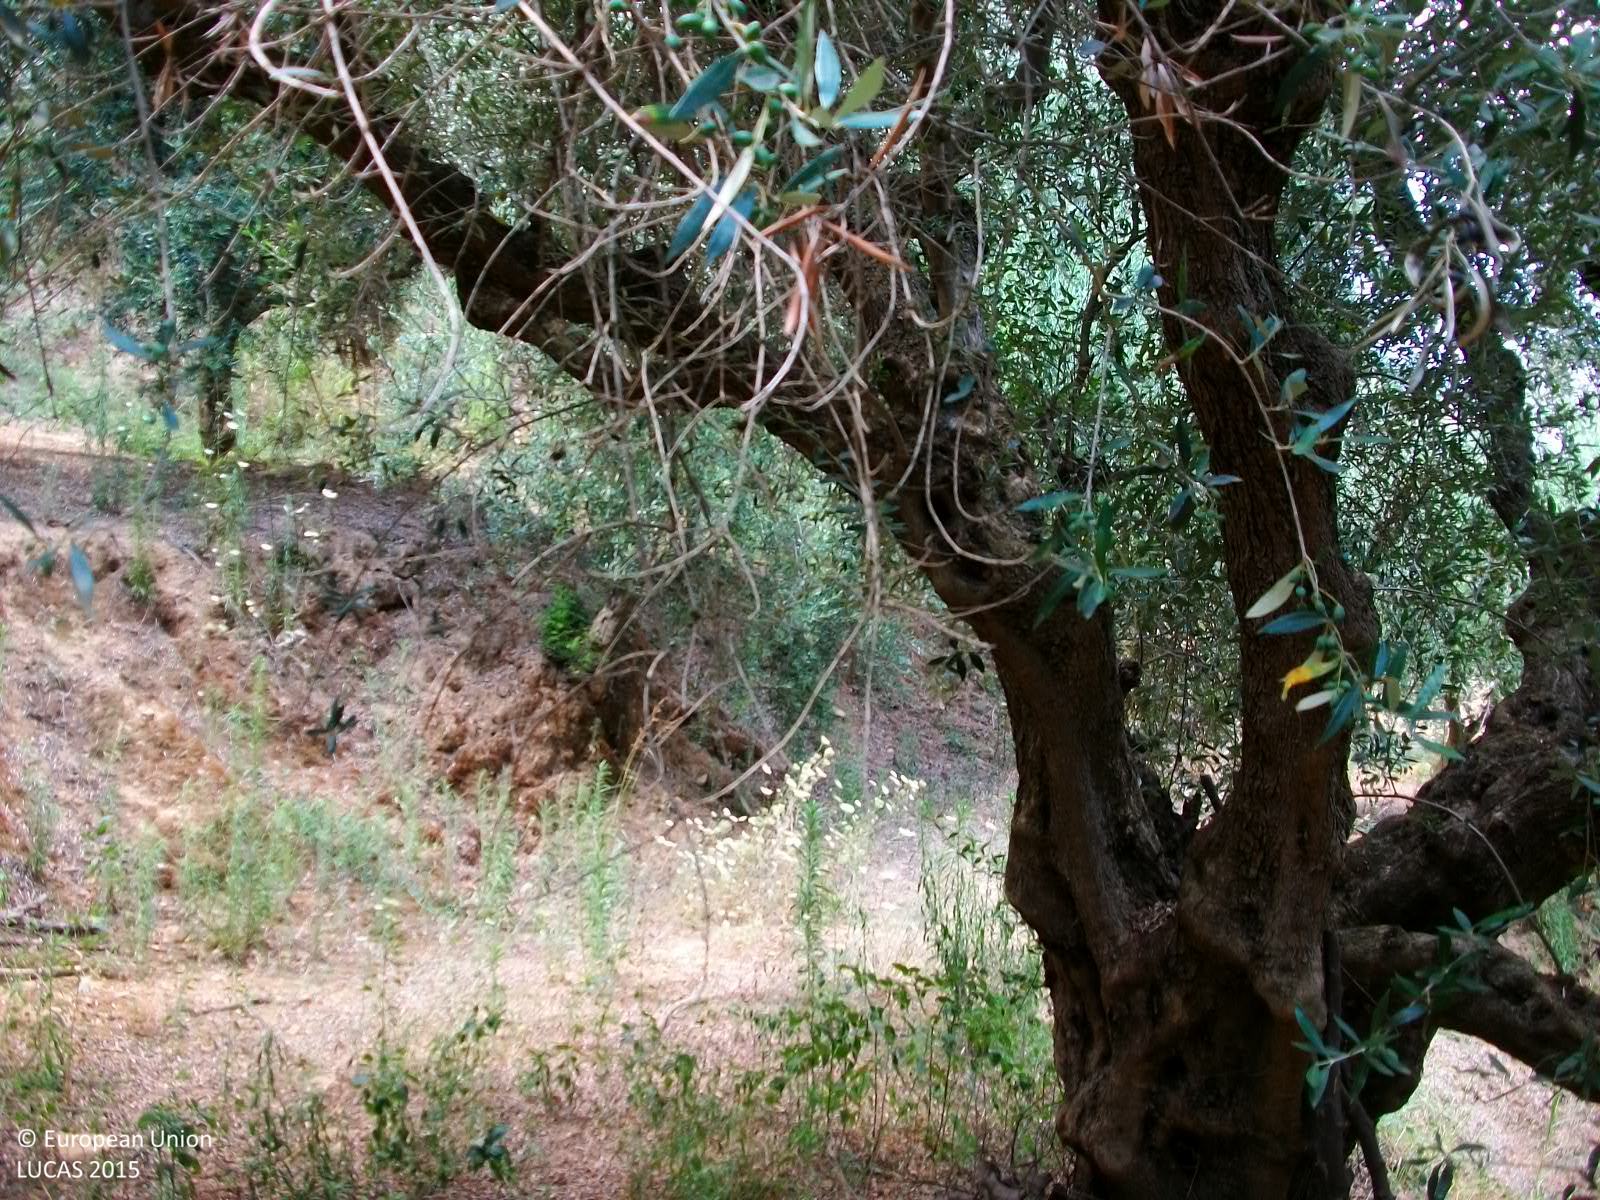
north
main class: Cropland
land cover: Olive groves
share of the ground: 50 - 75 %
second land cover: Spontaneously vegetated surfaces
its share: > 75 %
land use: Agriculture (excluding fallow land and kitchen gardens)
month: July
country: GR
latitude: 37.0819
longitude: 21.9561
